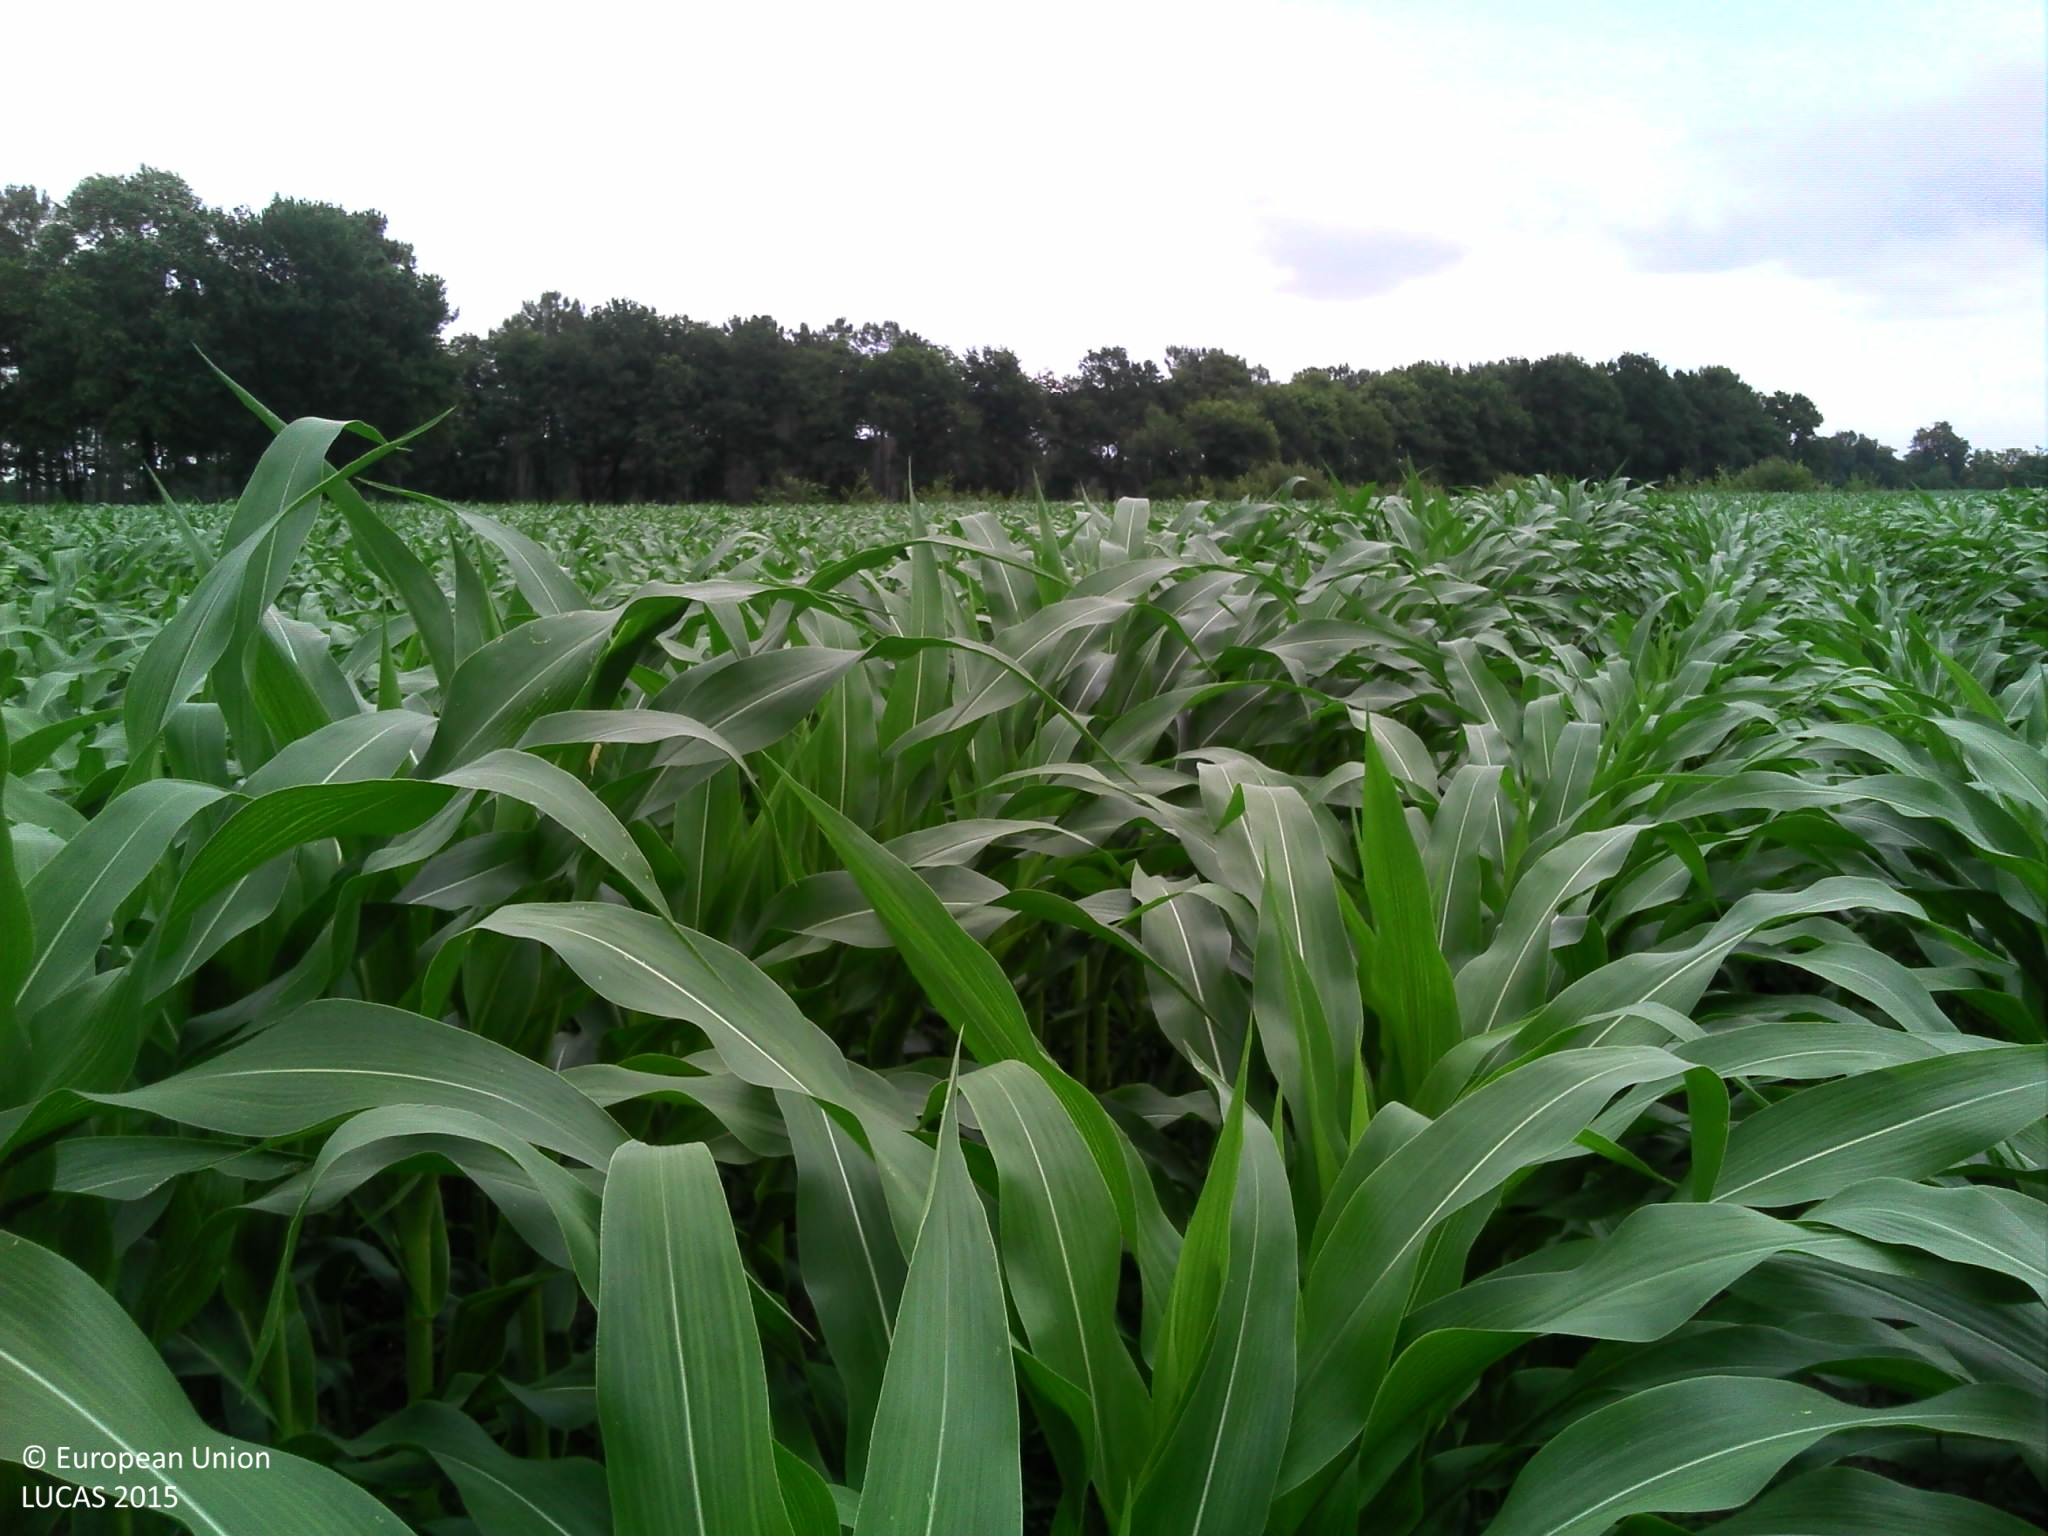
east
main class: Cropland
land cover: Maize
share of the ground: > 75 %
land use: Agriculture (excluding fallow land and kitchen gardens)
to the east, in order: Maize; Grass margins; Tracks; Abandoned hedges; Maize; Abandoned hedges; Tracks; Broadleaved woodland
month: July
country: FR
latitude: 43.5878
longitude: -0.7752
